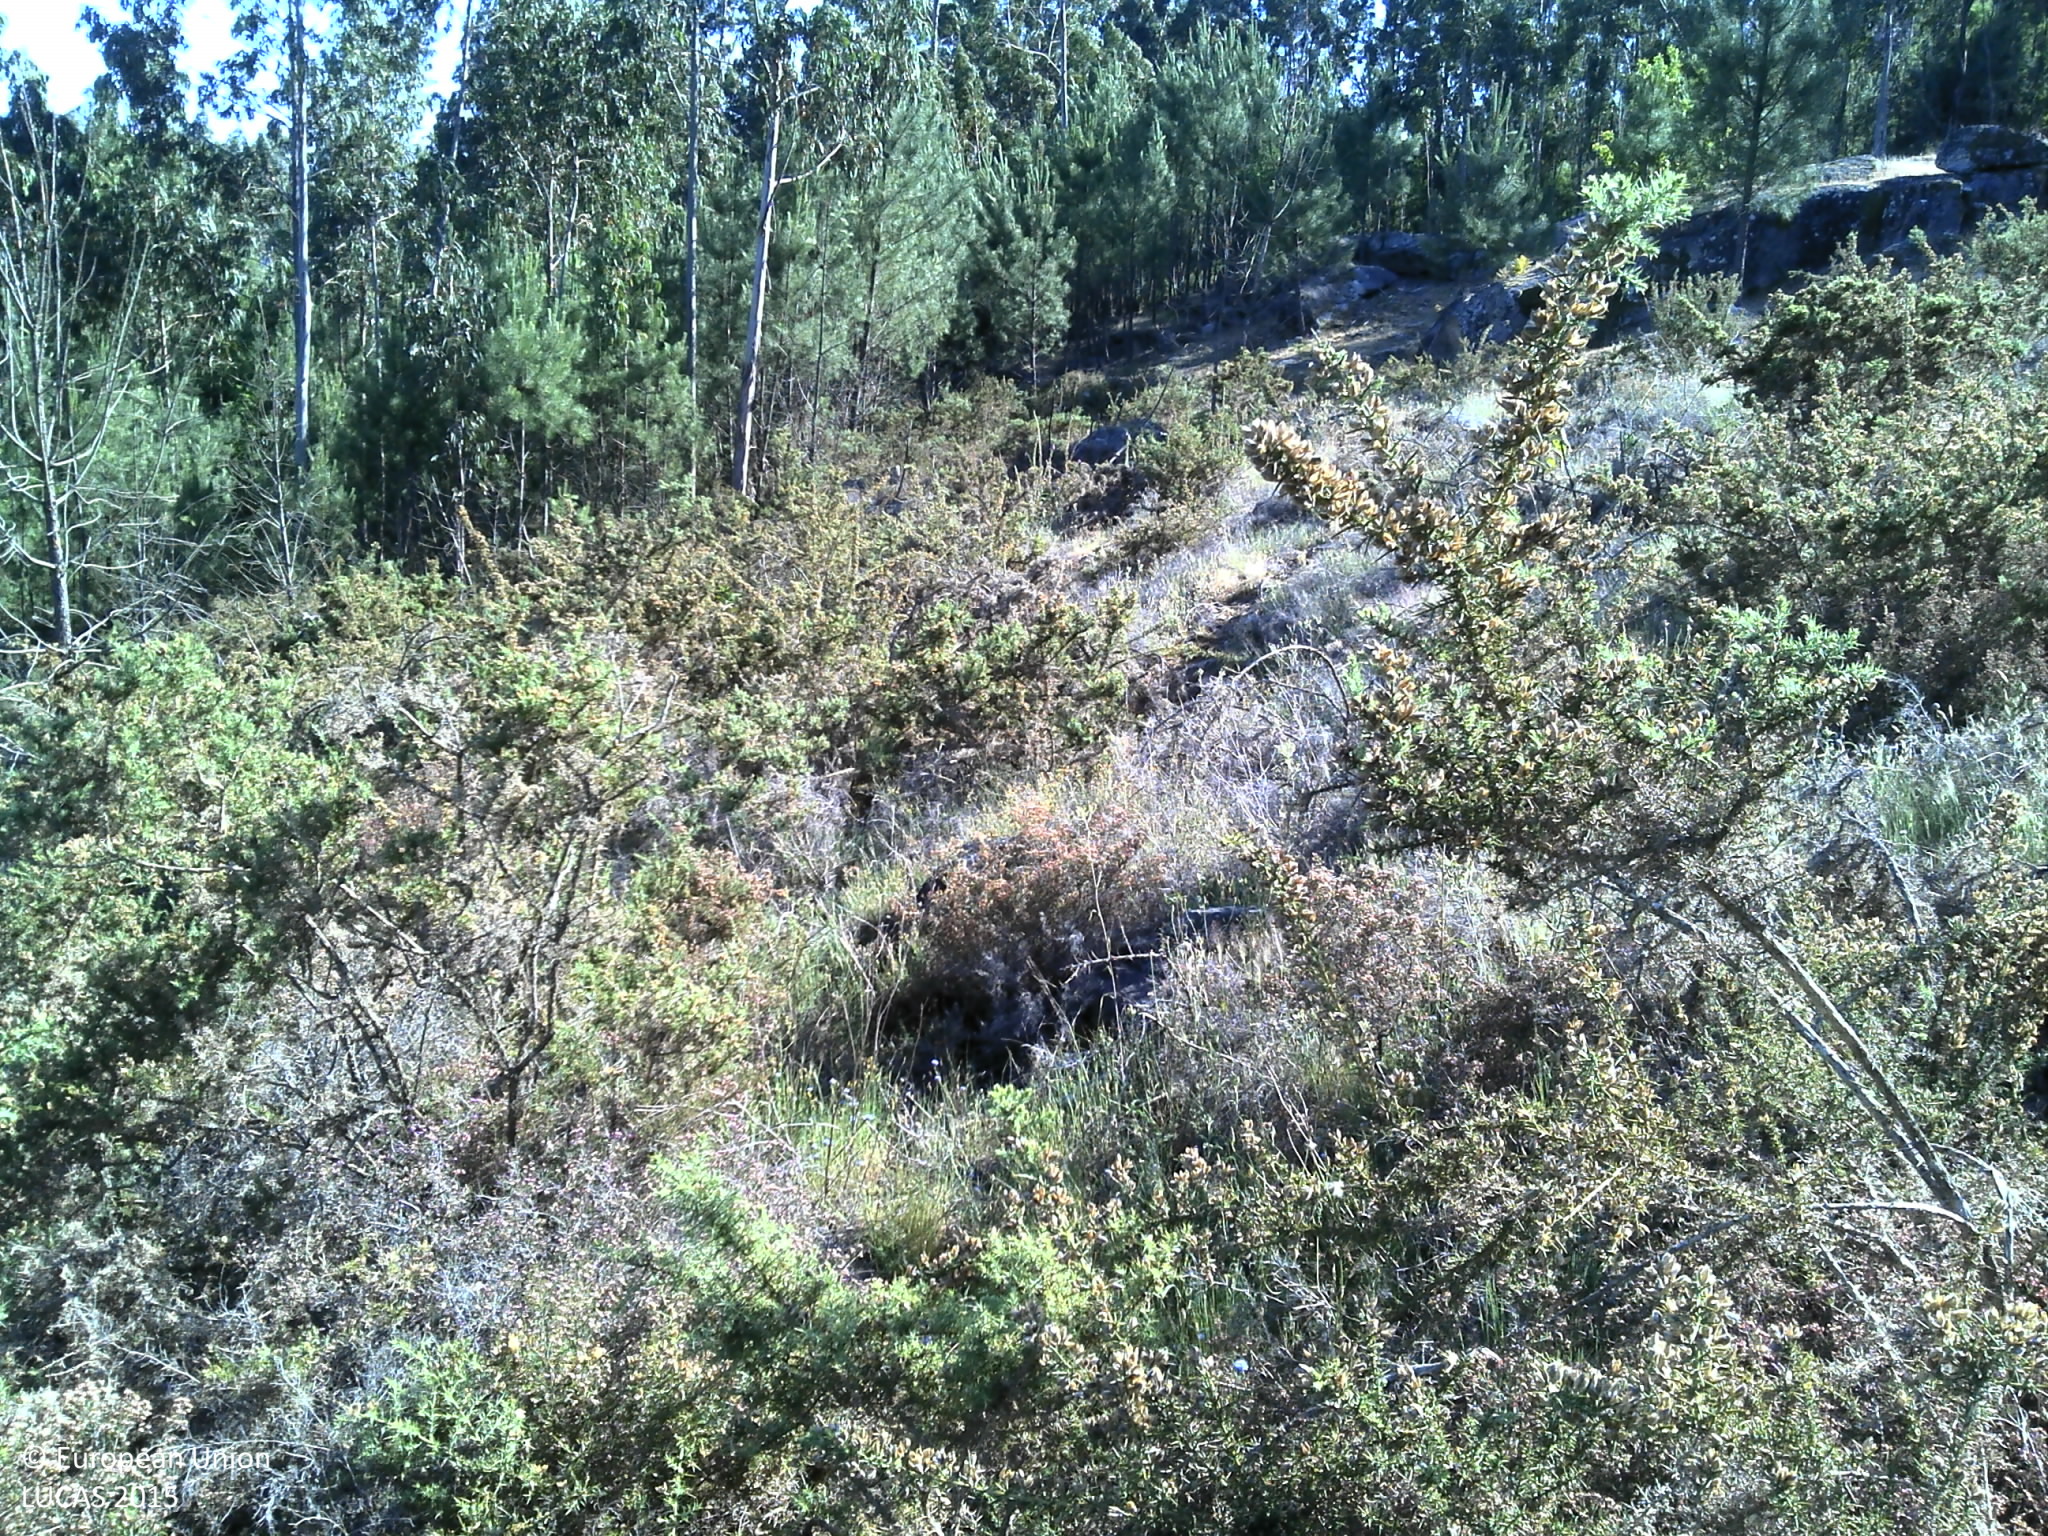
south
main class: Shrubland
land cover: Shrubland without tree cover
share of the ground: > 75 %
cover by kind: shrubs 80 %, herbaceous plants 10 %, unconsolidated bare surface 10 %
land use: Semi-natural and natural areas not in use
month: May
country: PT
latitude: 41.7542
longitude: -8.6488
